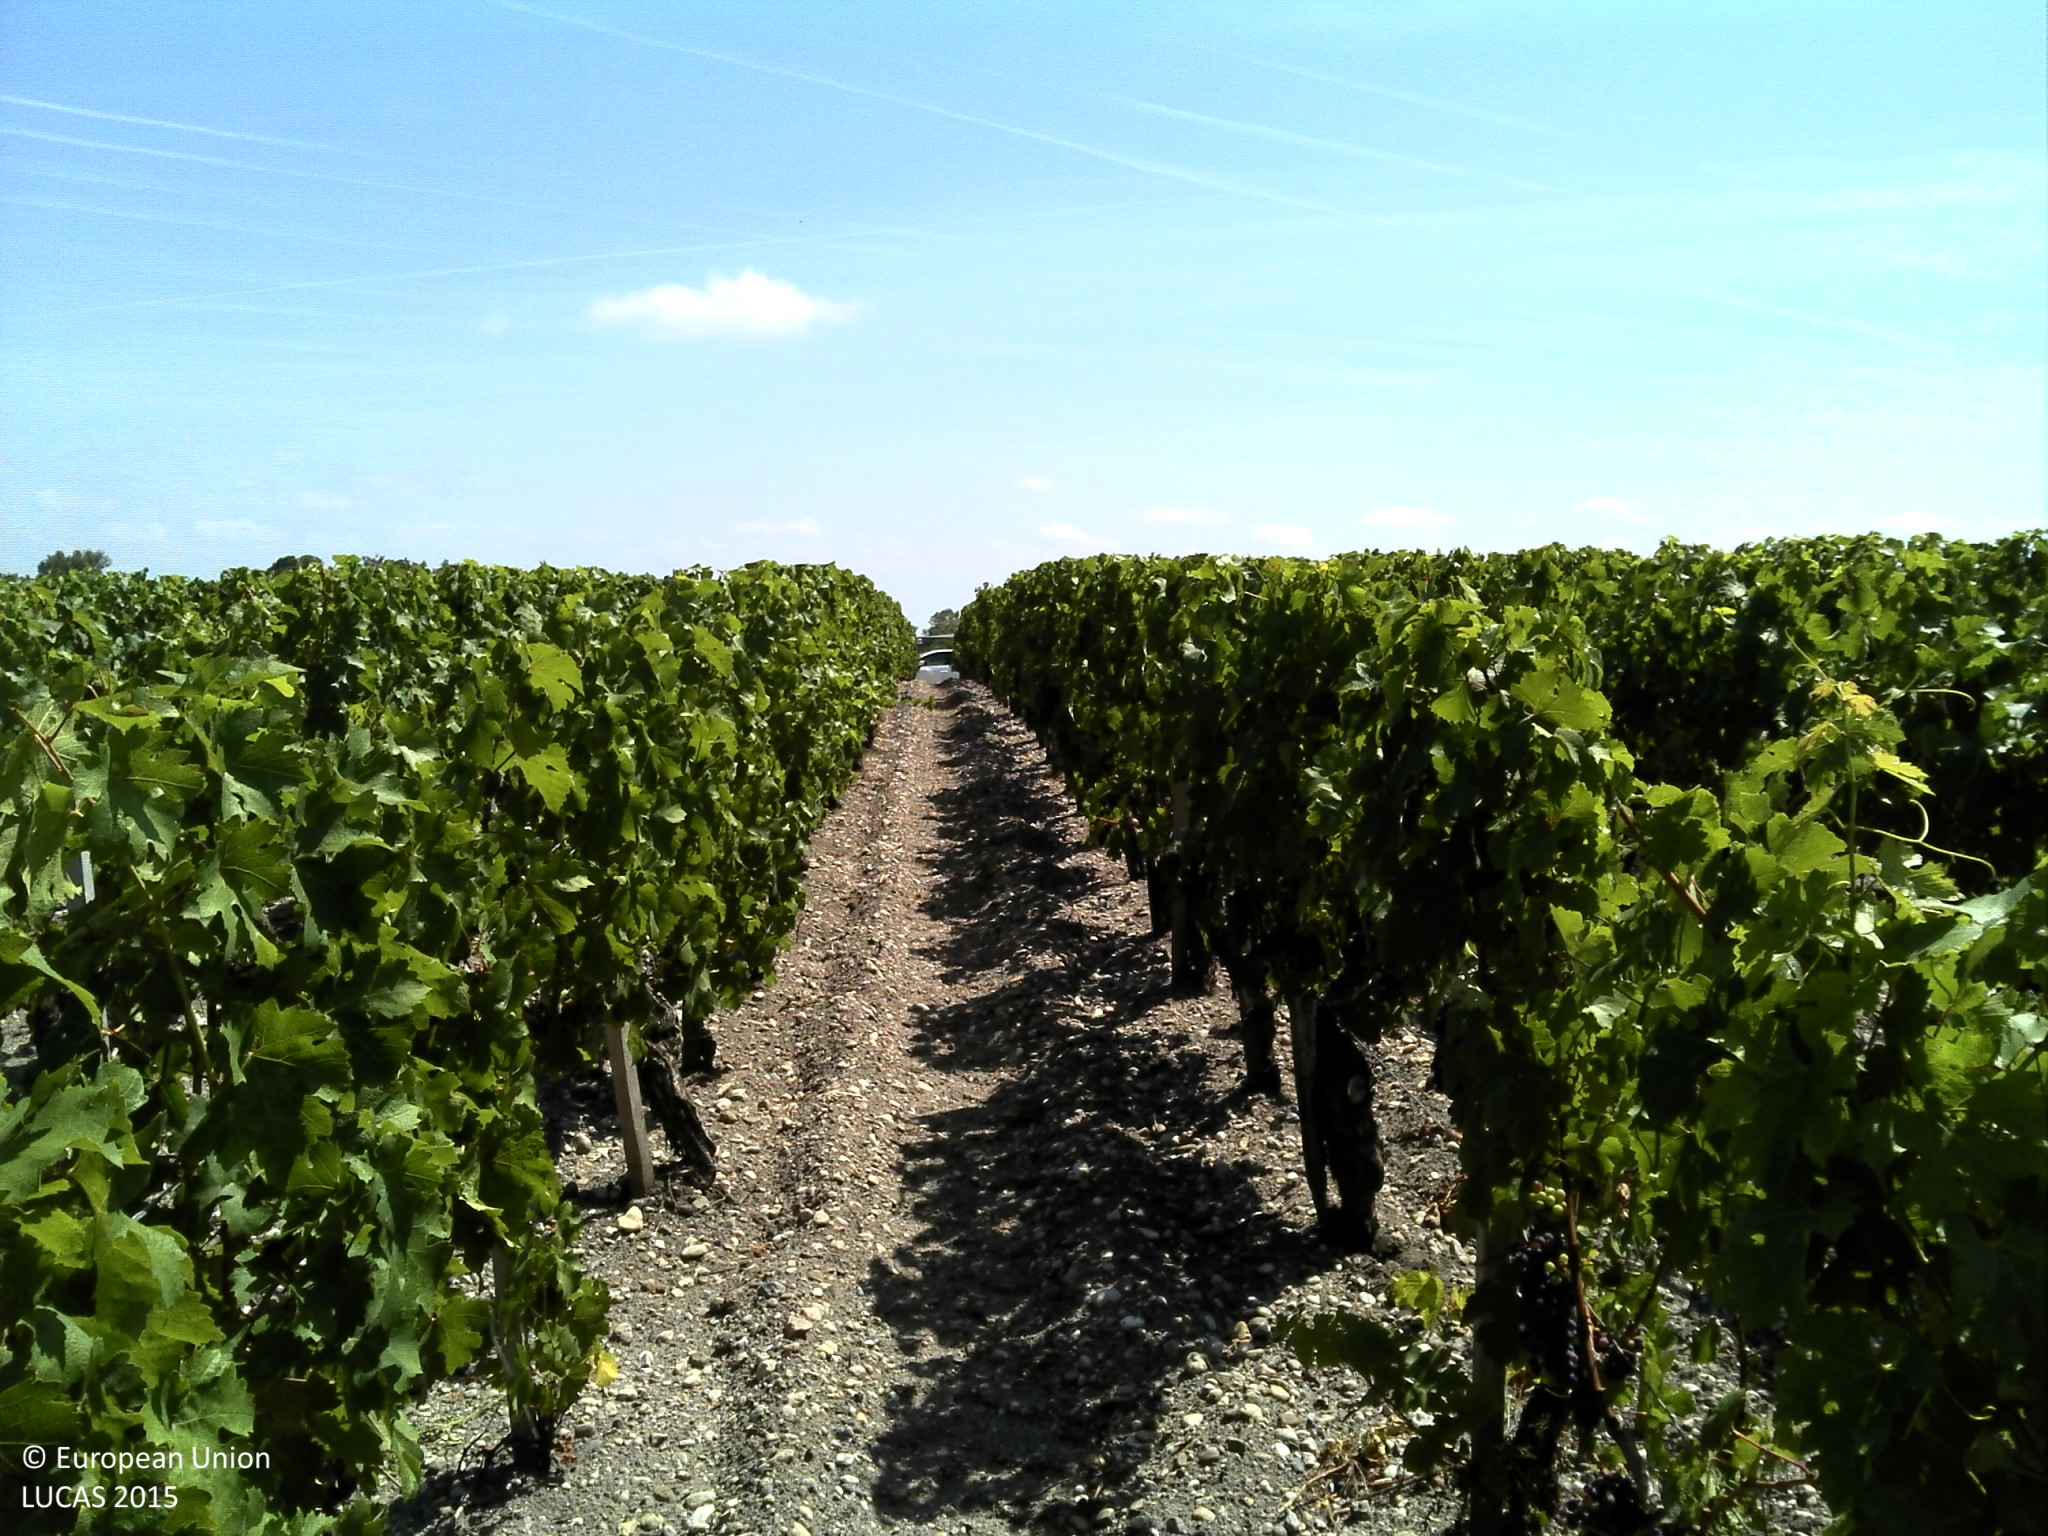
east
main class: Cropland
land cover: Vineyards
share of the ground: 25 - 50 %
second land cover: Other bare soil
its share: > 75 %
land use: Agriculture (excluding fallow land and kitchen gardens)
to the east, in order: Vineyards; Other bare soil; Tracks; Vineyards; Tracks; Vineyards; Tracks; Vineyards
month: August
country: FR
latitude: 45.1873
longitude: -0.7772
